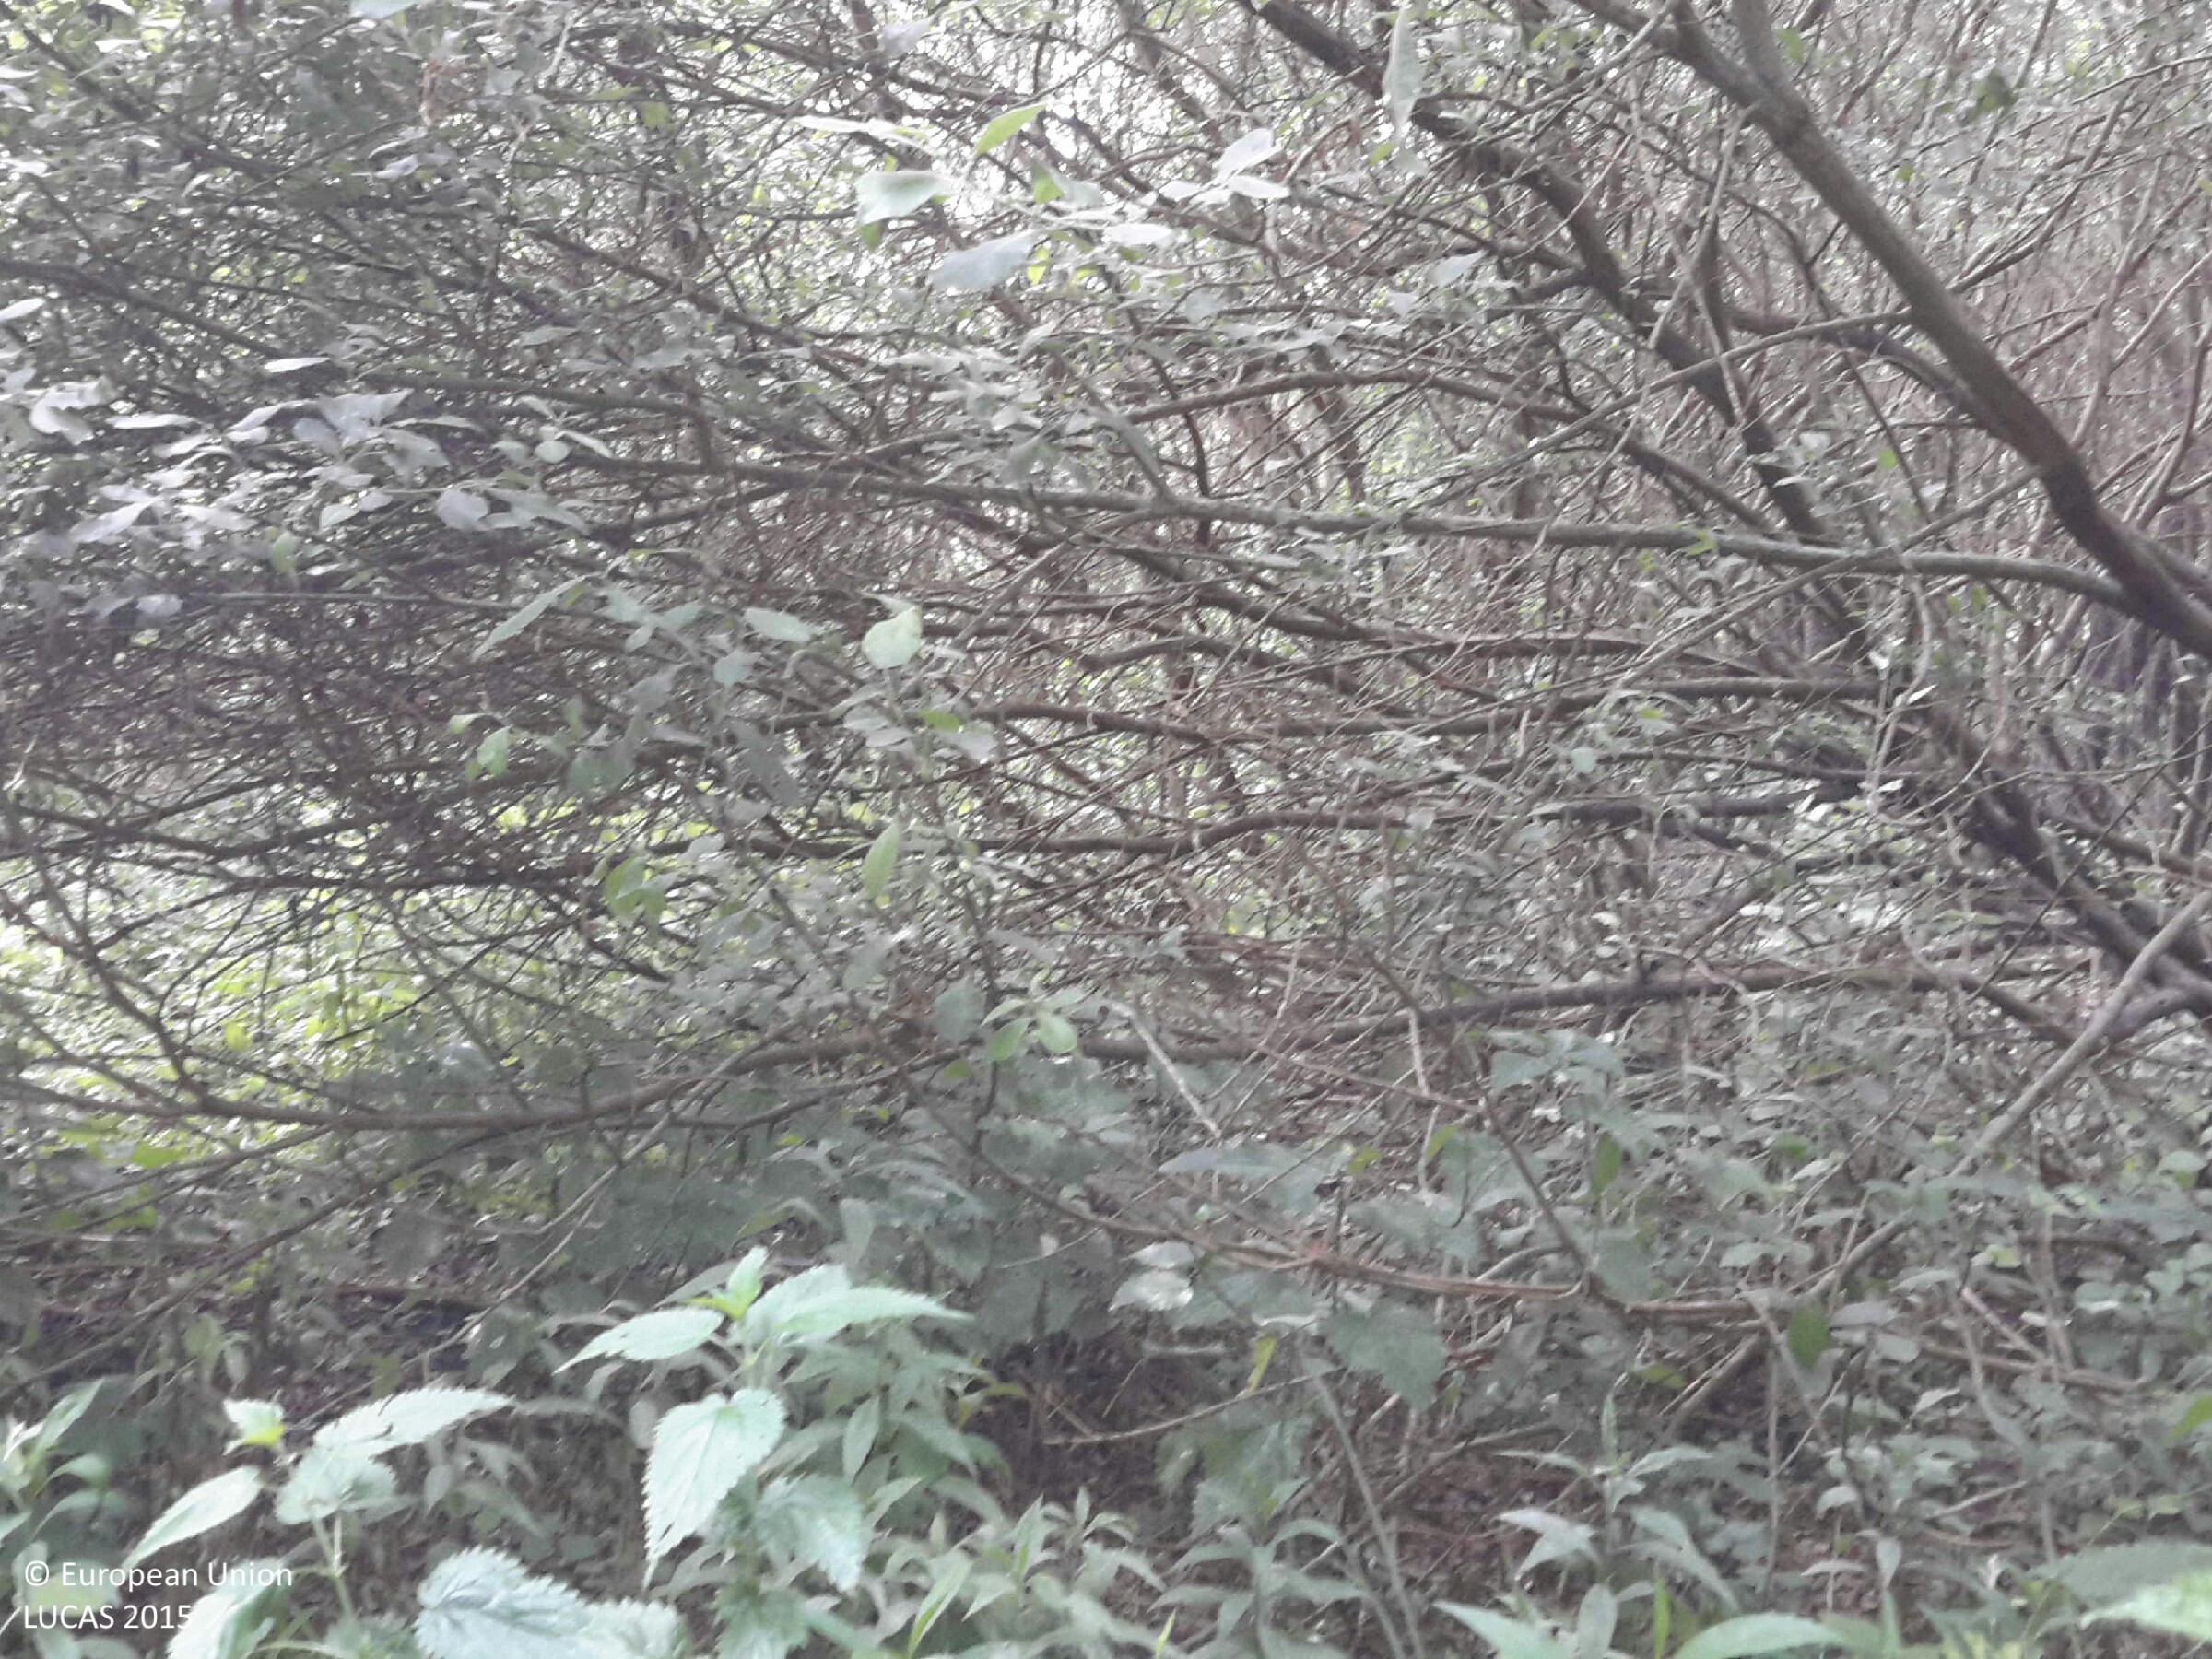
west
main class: Shrubland
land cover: Shrubland with sparse tree cover
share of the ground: > 75 %
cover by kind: shrubs 90 %, broadleaved forest trees 5 %, herbaceous plants 5 %
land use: Forestry
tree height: > 5 m
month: June
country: HU
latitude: 47.7176
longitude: 17.4601
